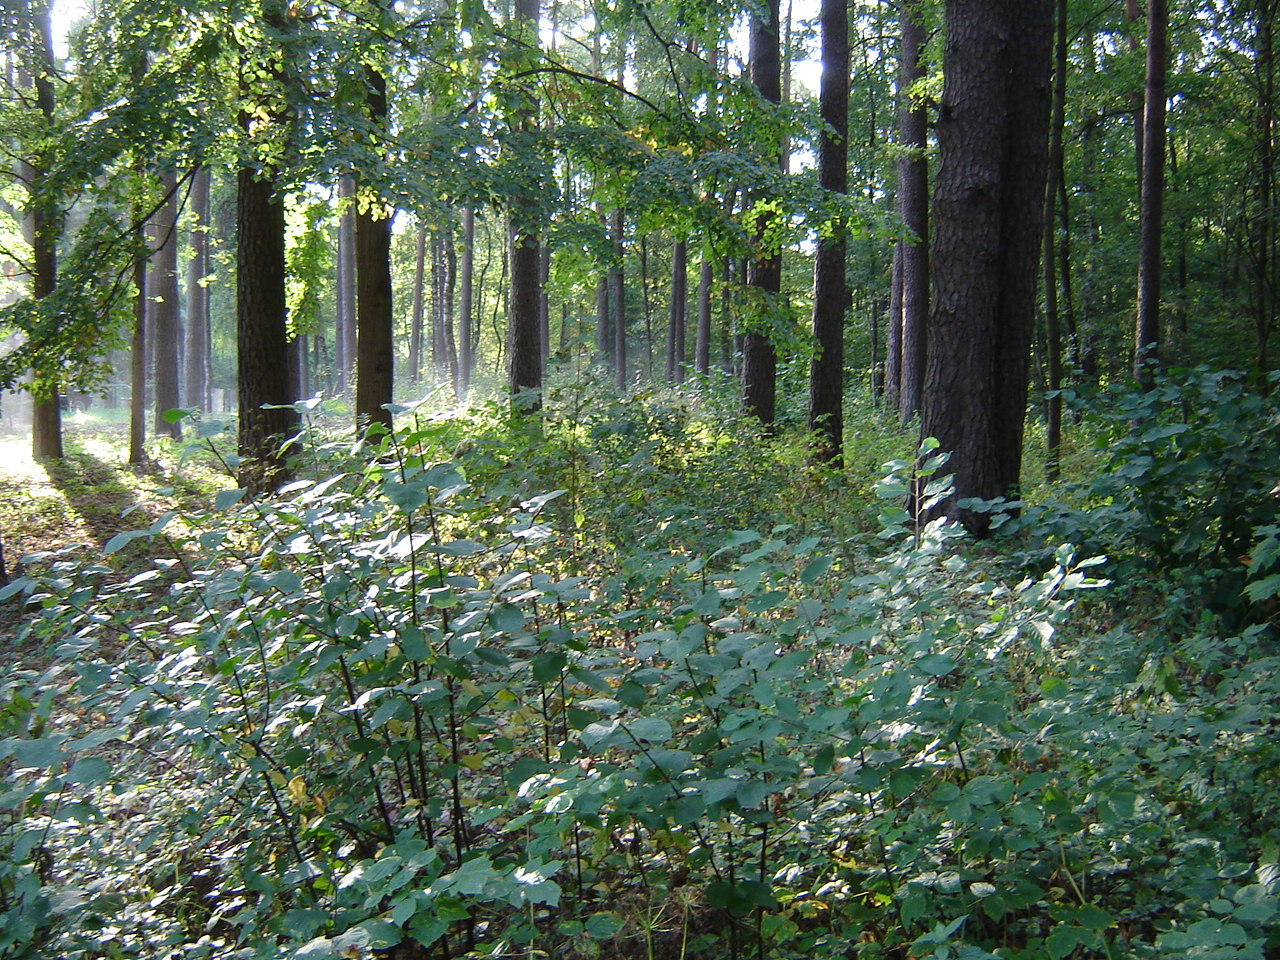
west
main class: Woodland
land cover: Pine dominated mixed woodland
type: hemiboreal forest and nemoral coniferous forest and mixed broadleaved-coniferous forest
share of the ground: > 75 %
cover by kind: coniferous forest trees 55 %, broadleaved forest trees 30 %, herbaceous plants 15 %
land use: Forestry
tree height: > 5 m
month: August
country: LT
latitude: 54.6125
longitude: 25.2167
